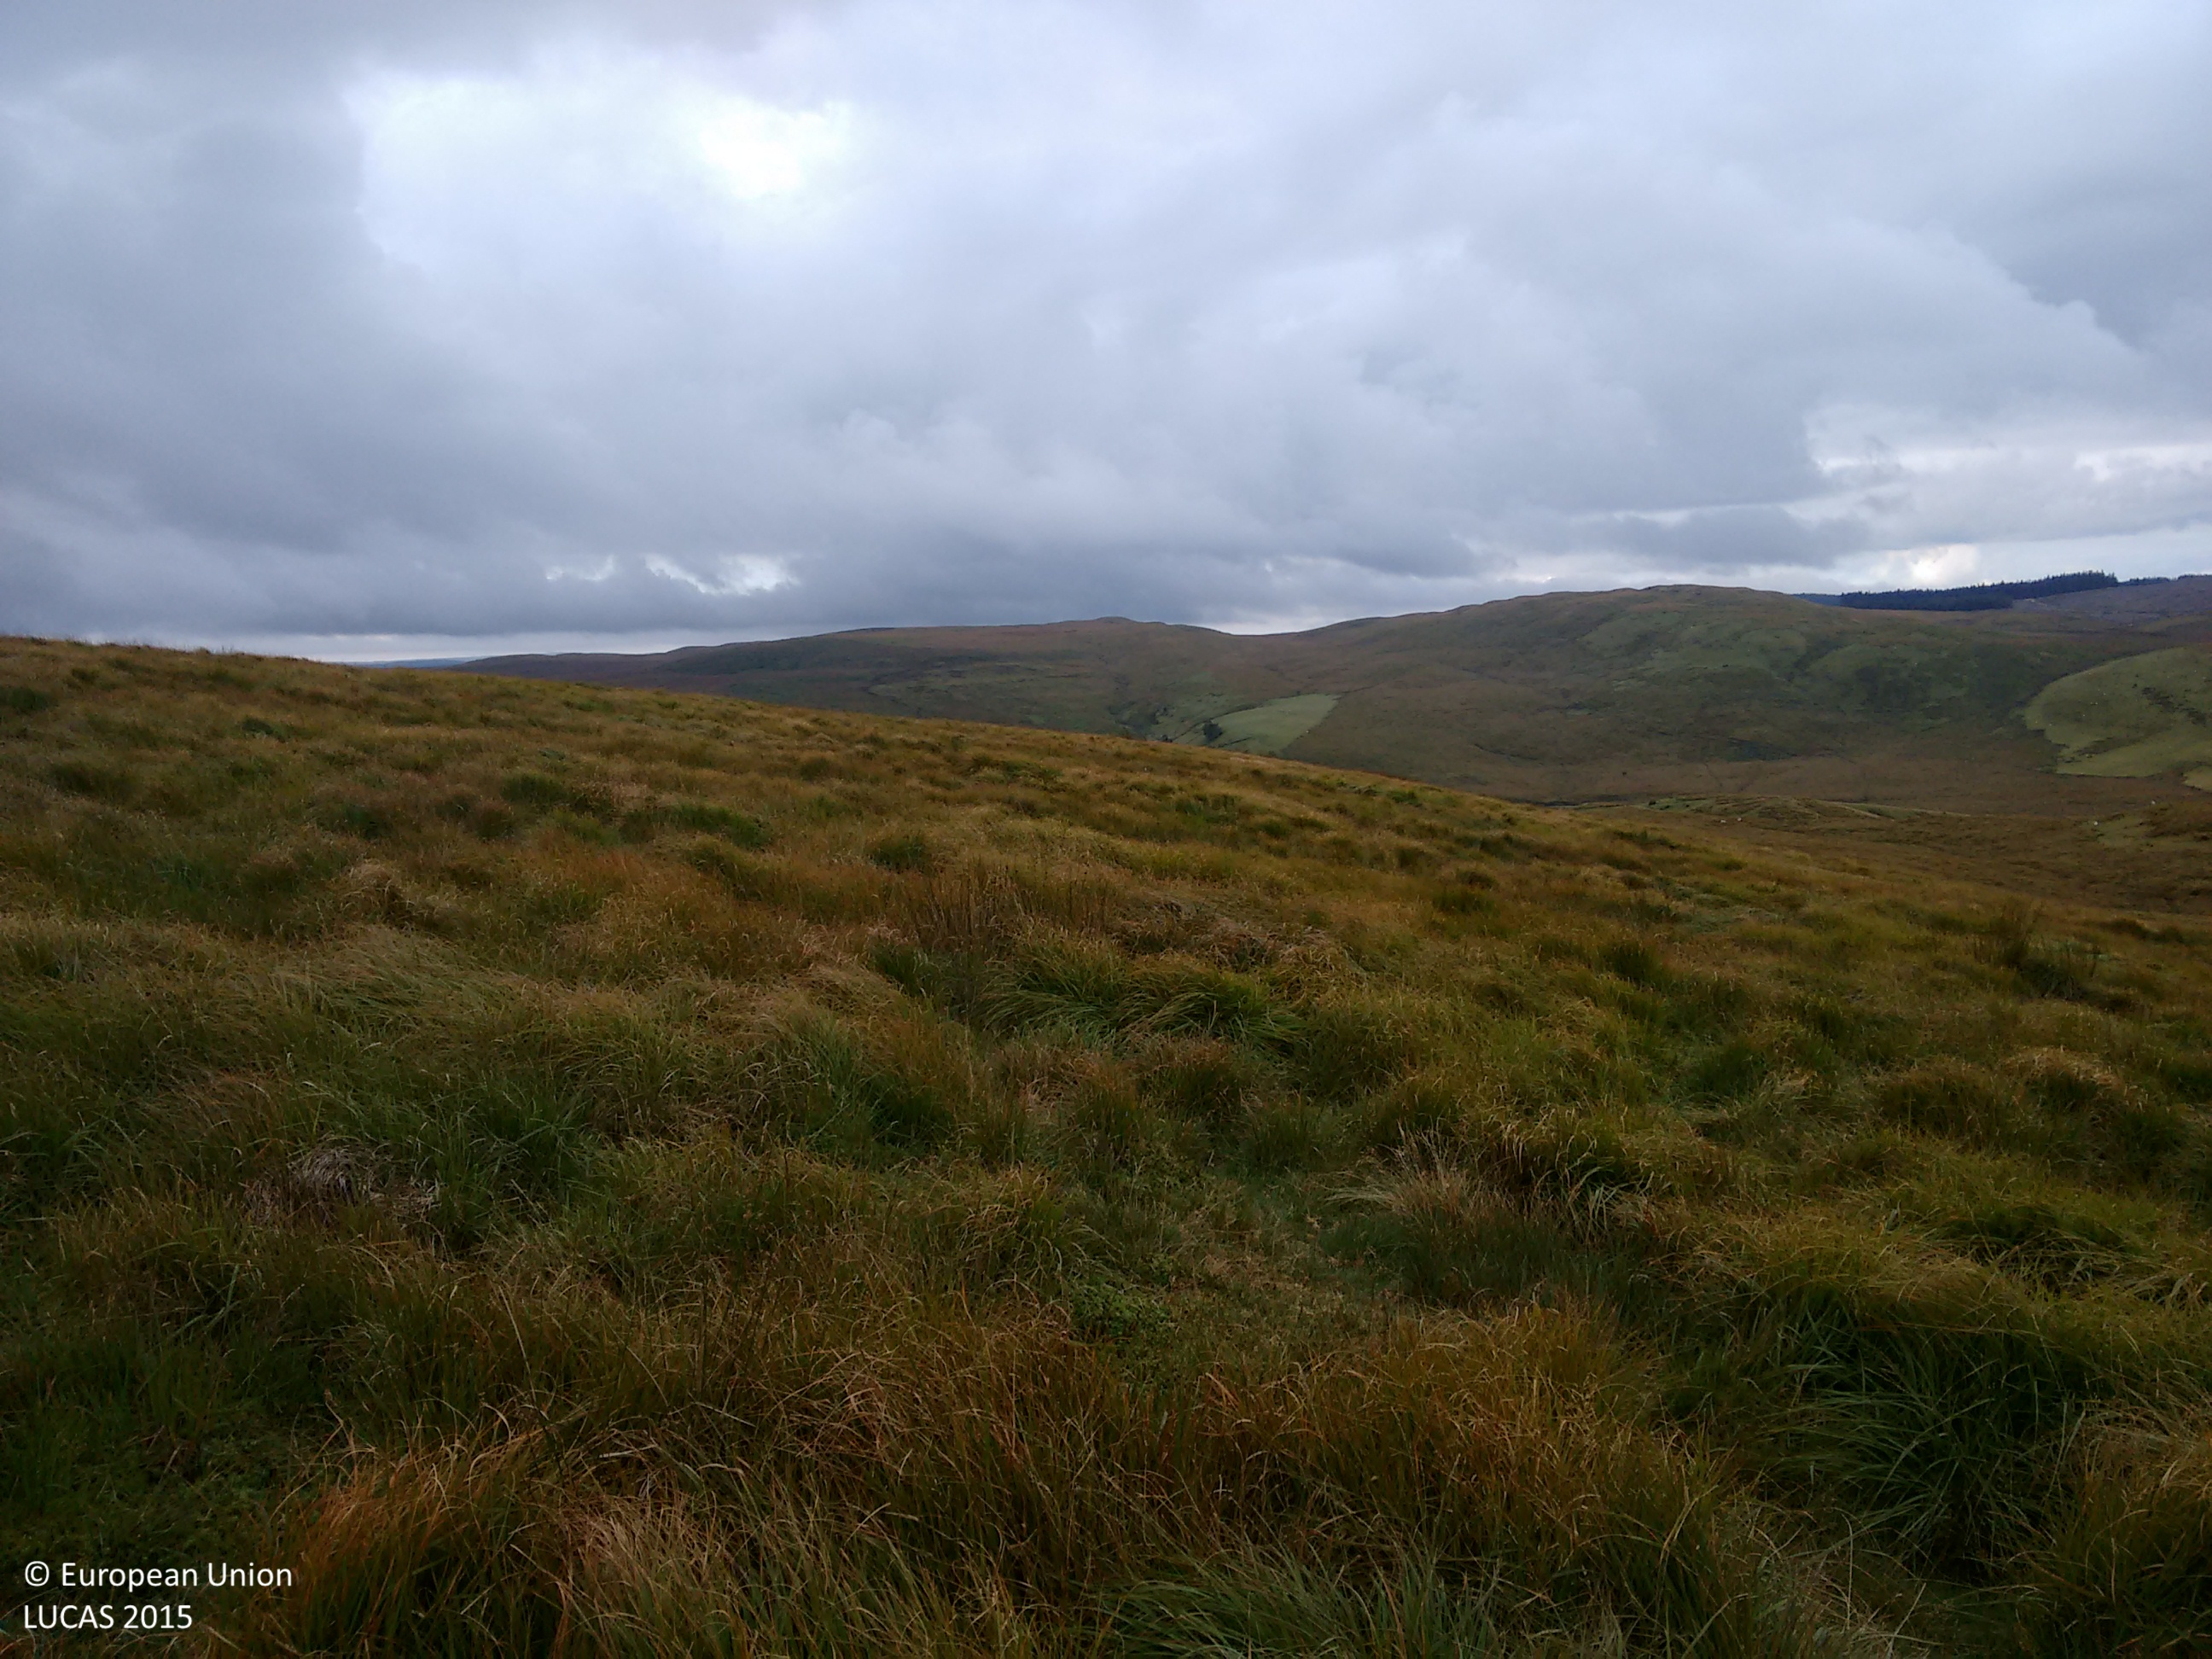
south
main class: Grassland
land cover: Grassland without tree/shrub cover
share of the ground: > 75 %
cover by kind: herbaceous plants 100 %
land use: Agriculture (excluding fallow land and kitchen gardens)
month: September
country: GB
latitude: 52.2049
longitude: -3.8015
